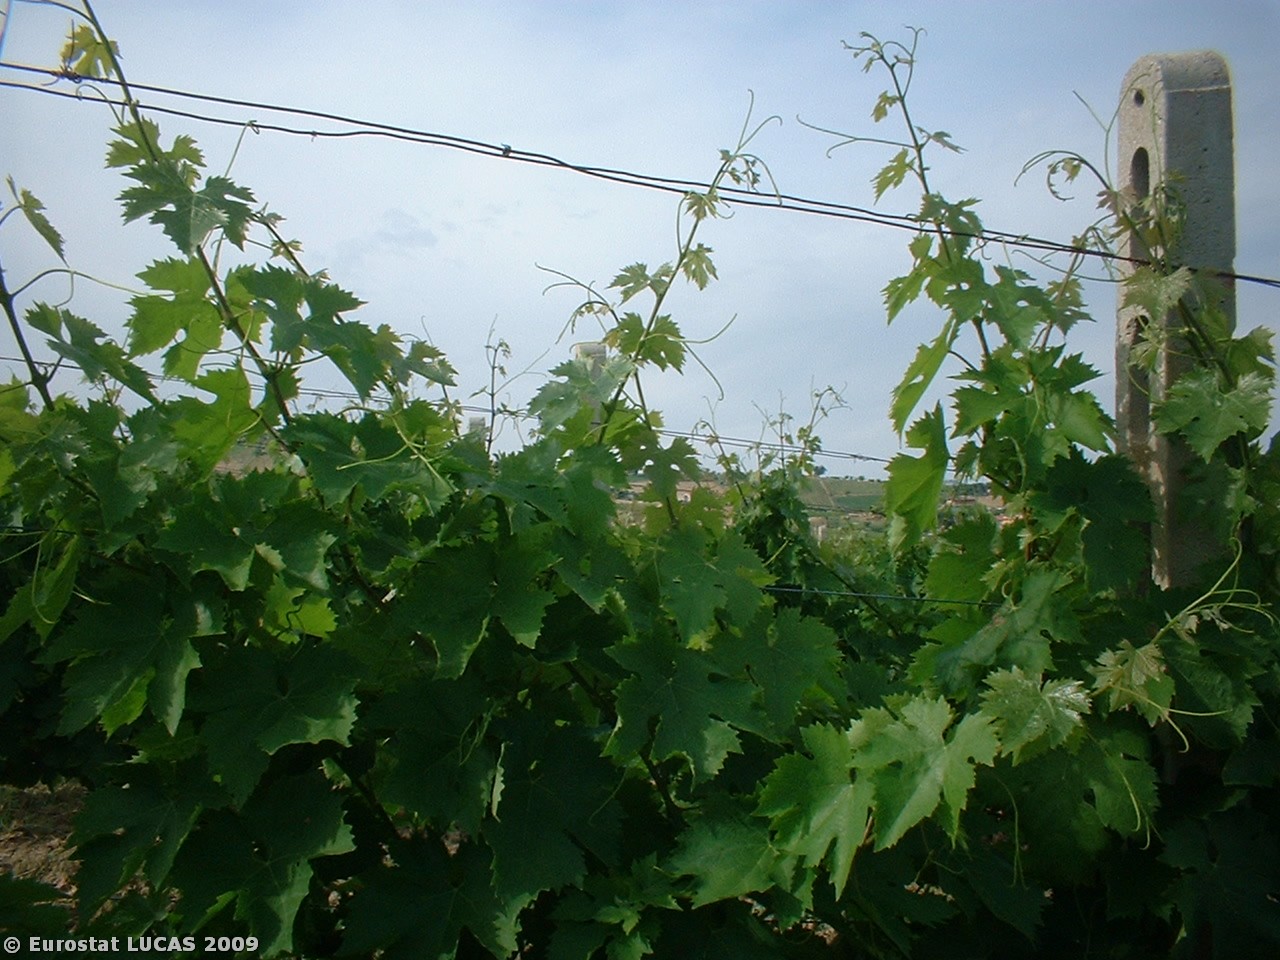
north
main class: Cropland
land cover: Vineyards
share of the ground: 25 - 50 %
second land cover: Bare land
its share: > 75 %
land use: Agriculture (excluding fallow land and kitchen gardens)
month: June
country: IT
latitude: 42.9289
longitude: 13.7268
